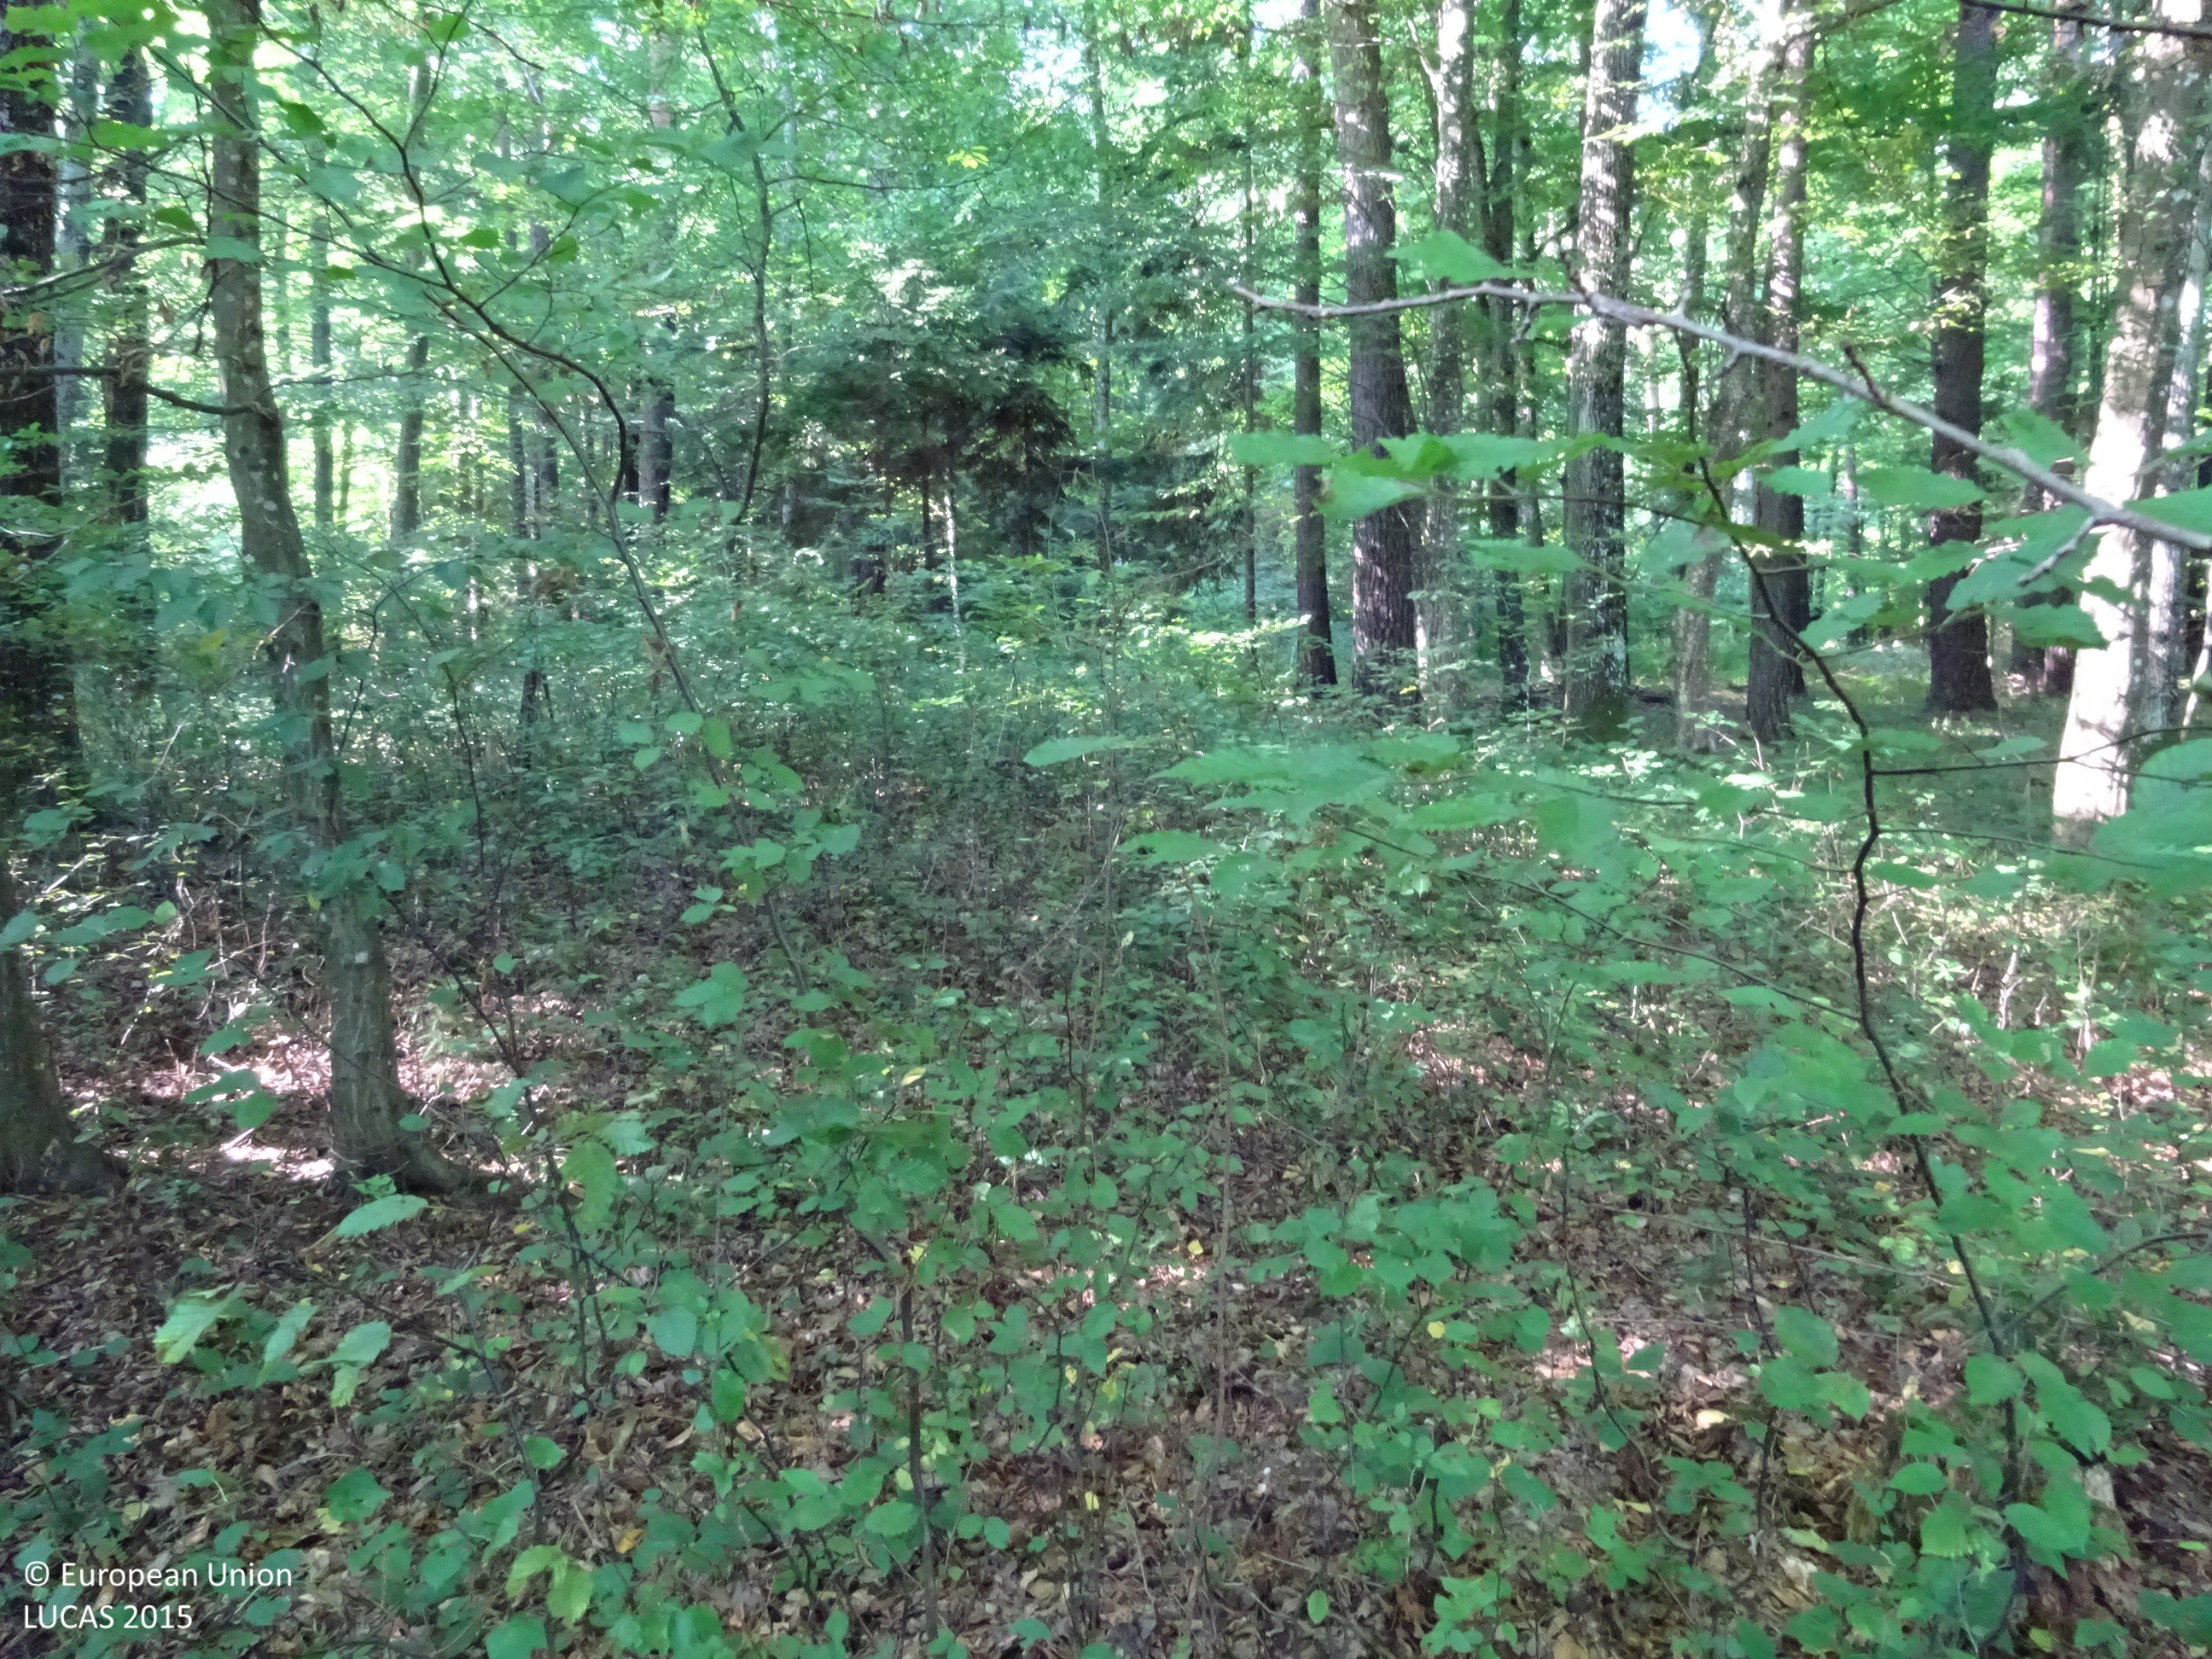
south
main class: Woodland
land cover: Broadleaved woodland
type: mesophytic deciduous forest
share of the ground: > 75 %
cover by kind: broadleaved forest trees 90 %, coniferous forest trees 10 %
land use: Forestry
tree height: > 5 m
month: August
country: AT
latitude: 47.3743
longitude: 16.0013
